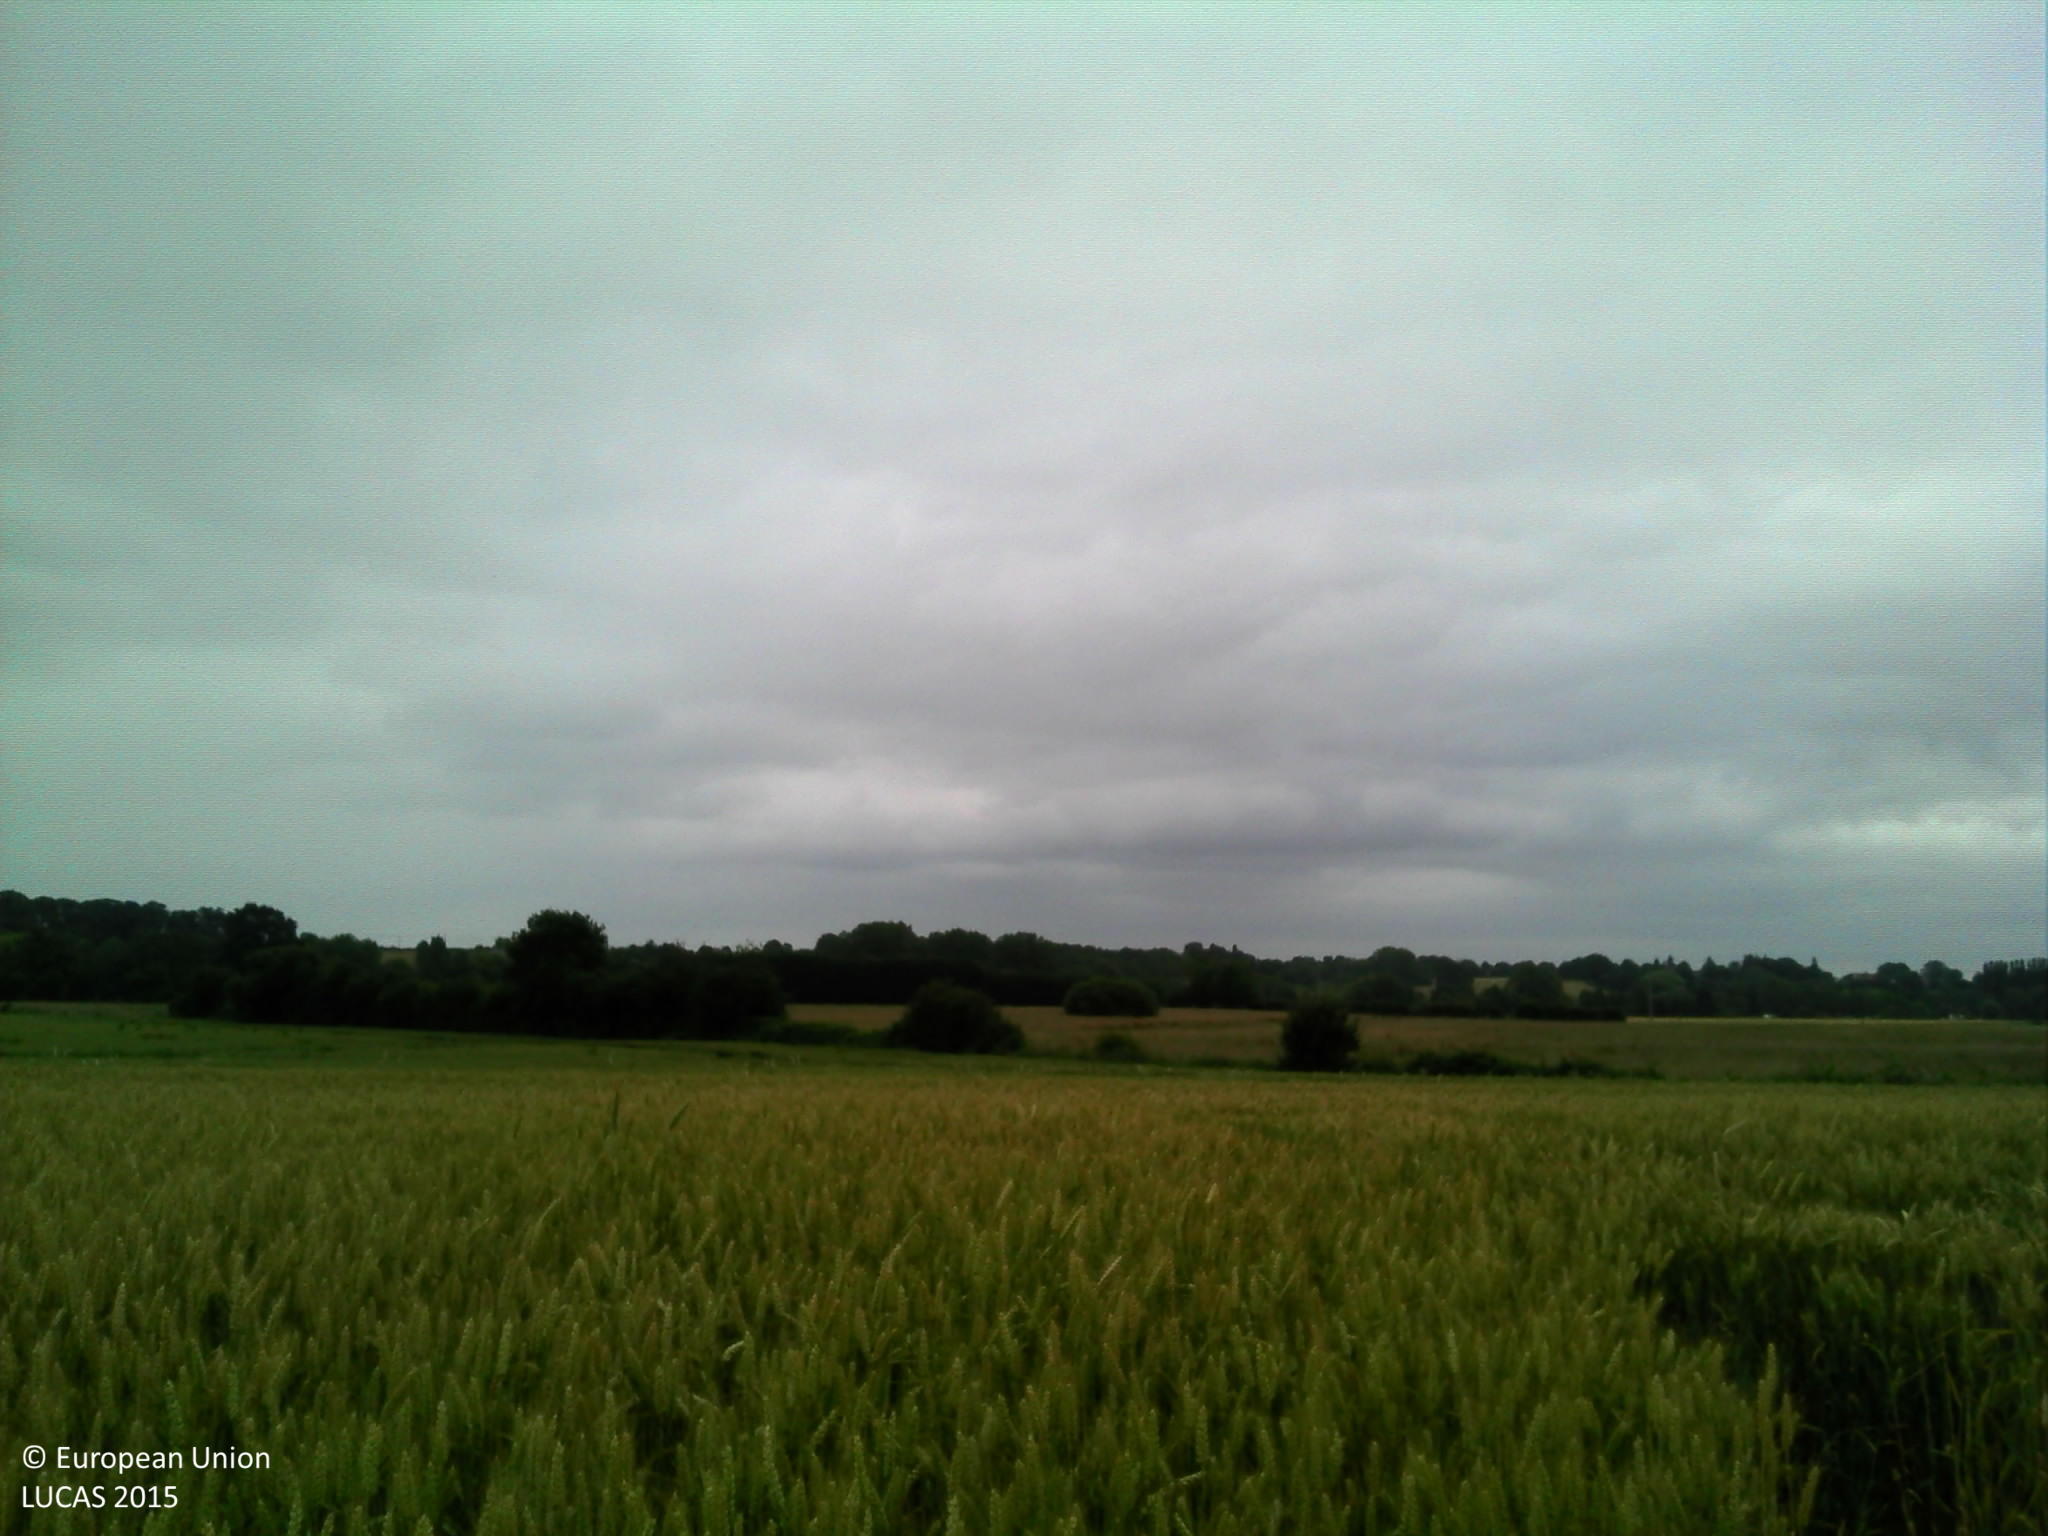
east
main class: Cropland
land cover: Common wheat
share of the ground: > 75 %
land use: Agriculture (excluding fallow land and kitchen gardens)
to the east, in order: Common wheat; Abandoned hedges; Fences; Grassland without tree/shrub cover
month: June
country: FR
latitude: 48.1284
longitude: 0.1786
